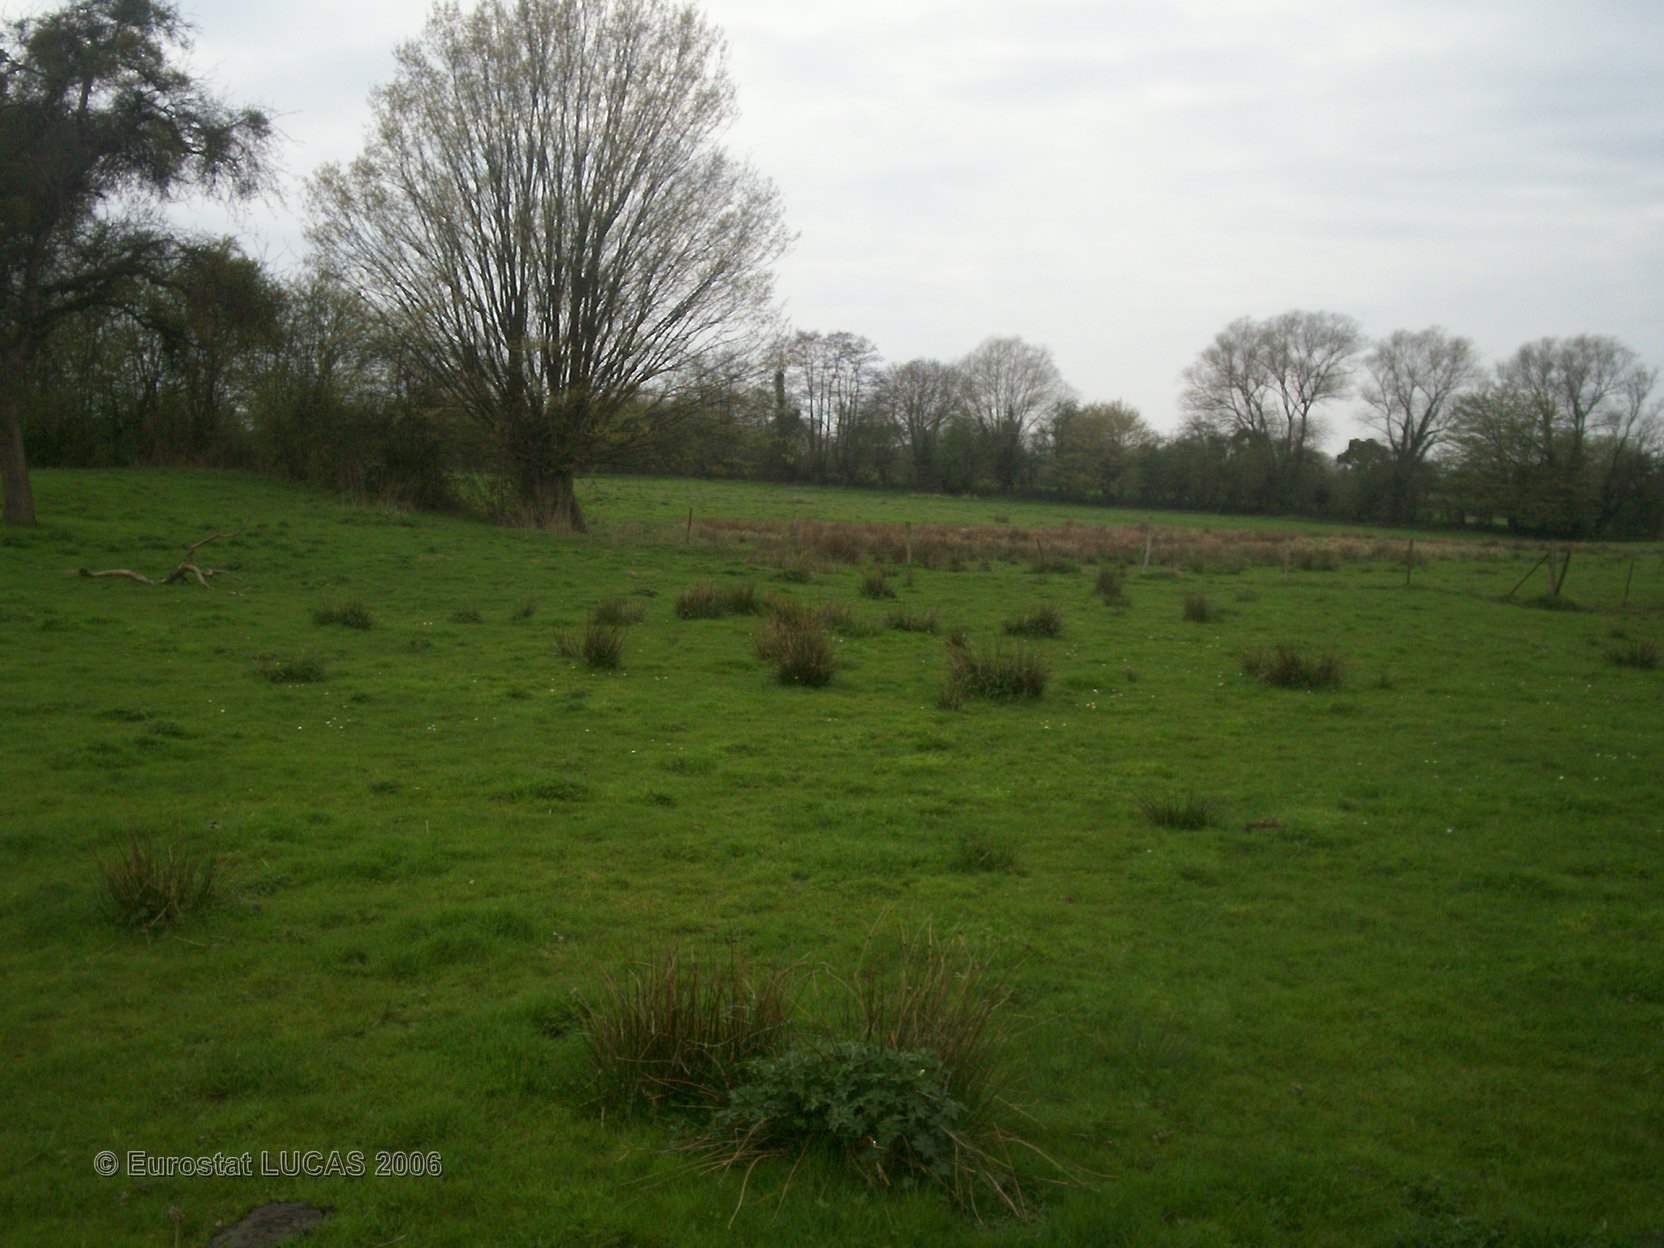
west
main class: Grassland
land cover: Grassland without tree/shrub cover
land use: Agriculture (excluding fallow land and kitchen gardens)
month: April
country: FR
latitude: 50.1011
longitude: 3.7160
